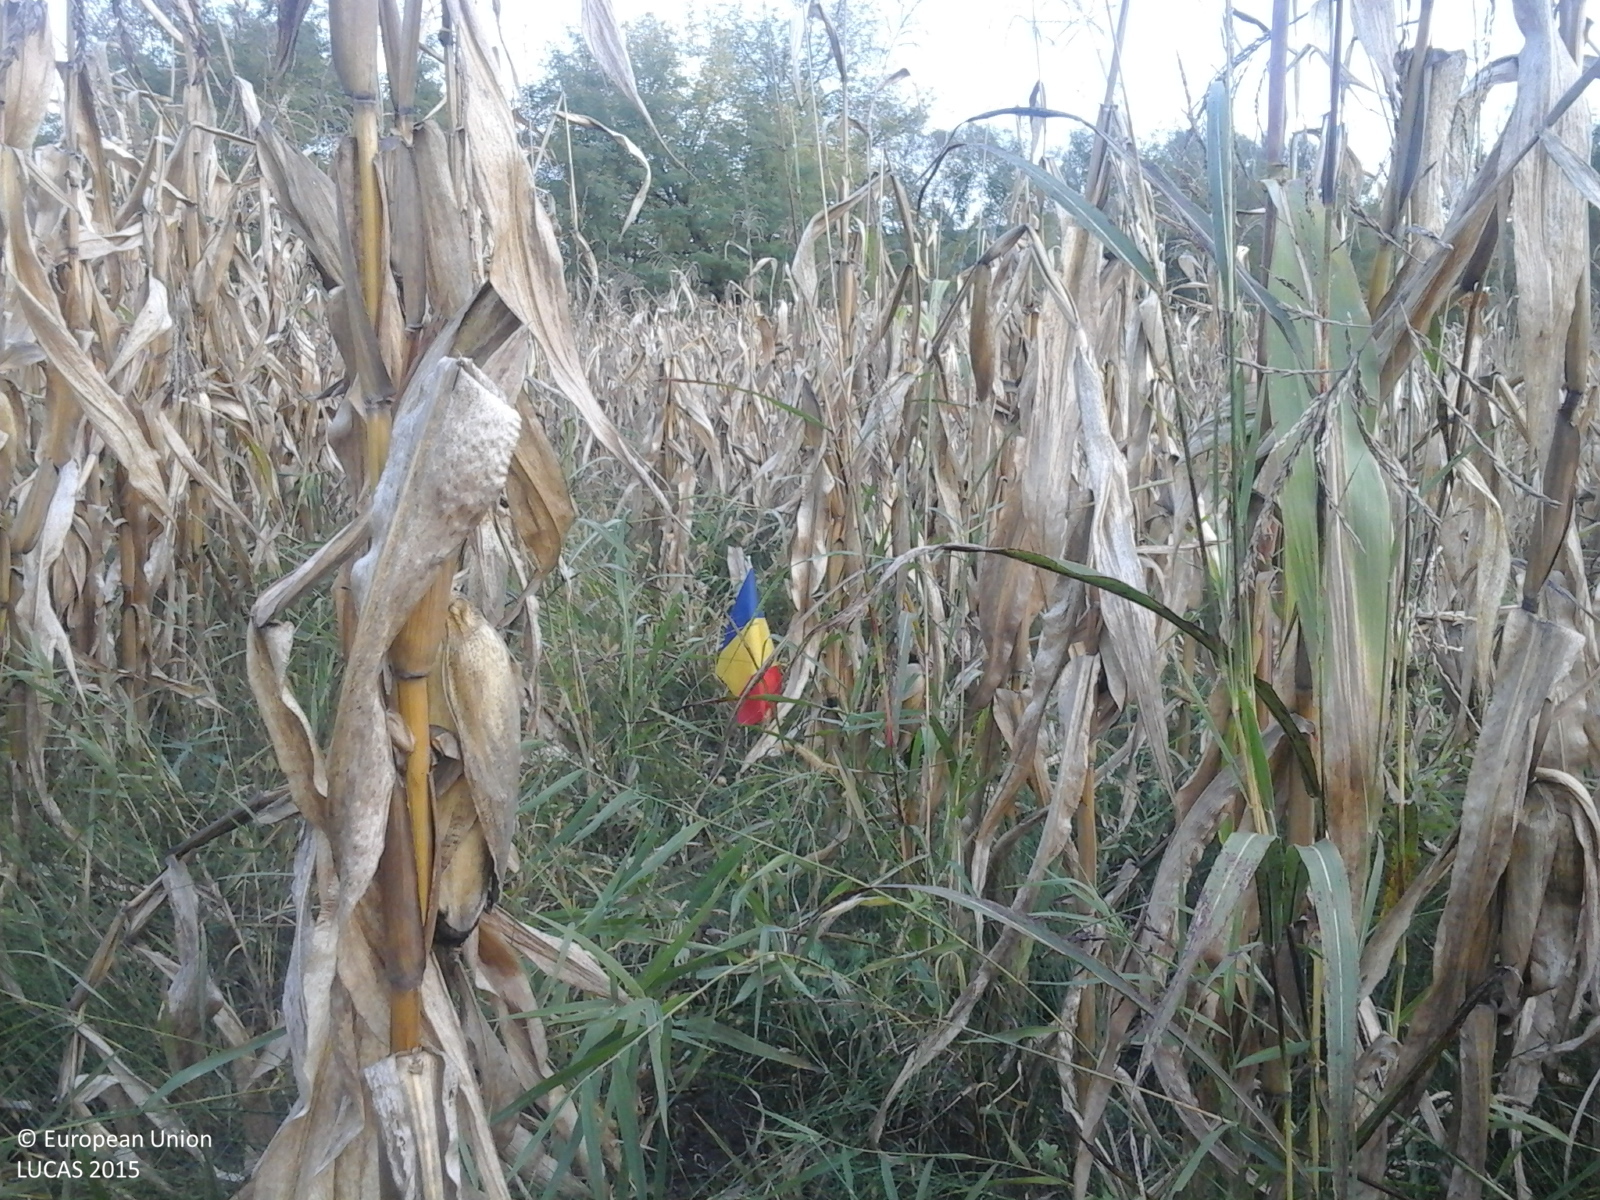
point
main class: Cropland
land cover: Maize
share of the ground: > 75 %
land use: Agriculture (excluding fallow land and kitchen gardens)
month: October
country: RO
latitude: 46.2145
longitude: 24.5124
